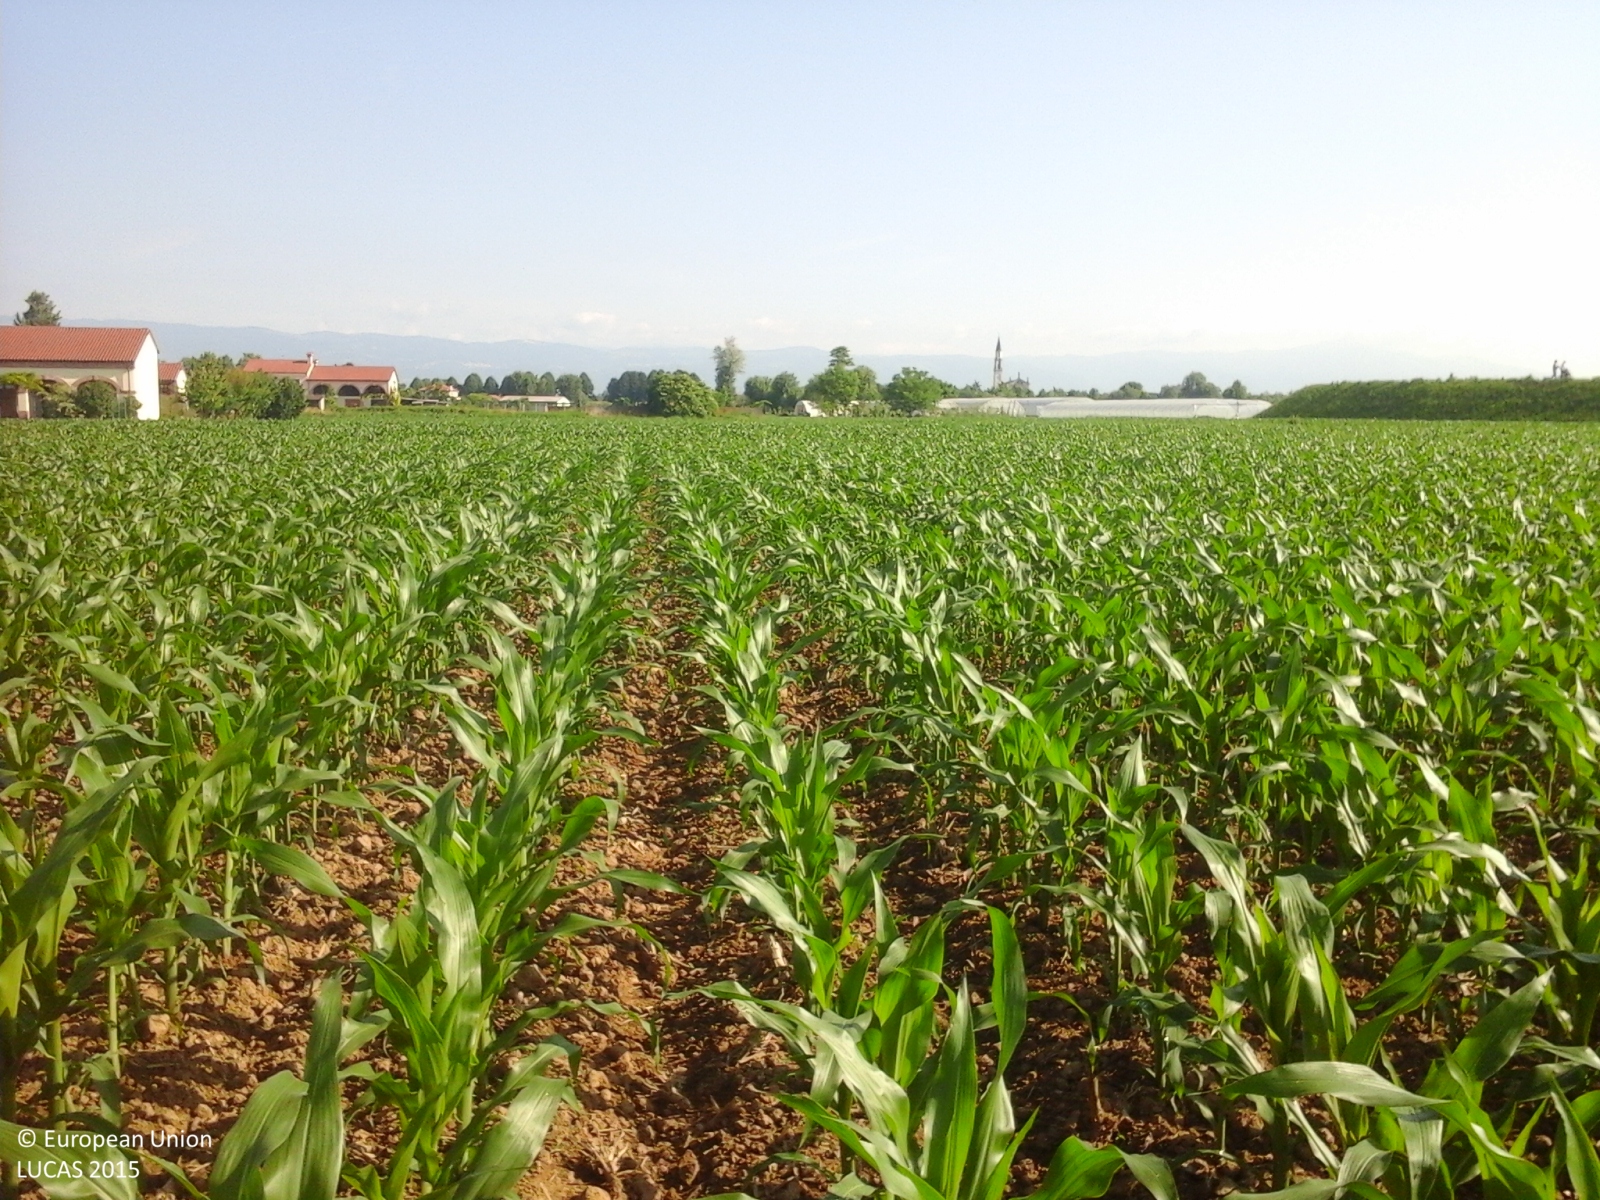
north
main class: Cropland
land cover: Maize
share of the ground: 50 - 75 %
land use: Agriculture (excluding fallow land and kitchen gardens)
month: May
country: IT
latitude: 45.5640
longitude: 11.6245
